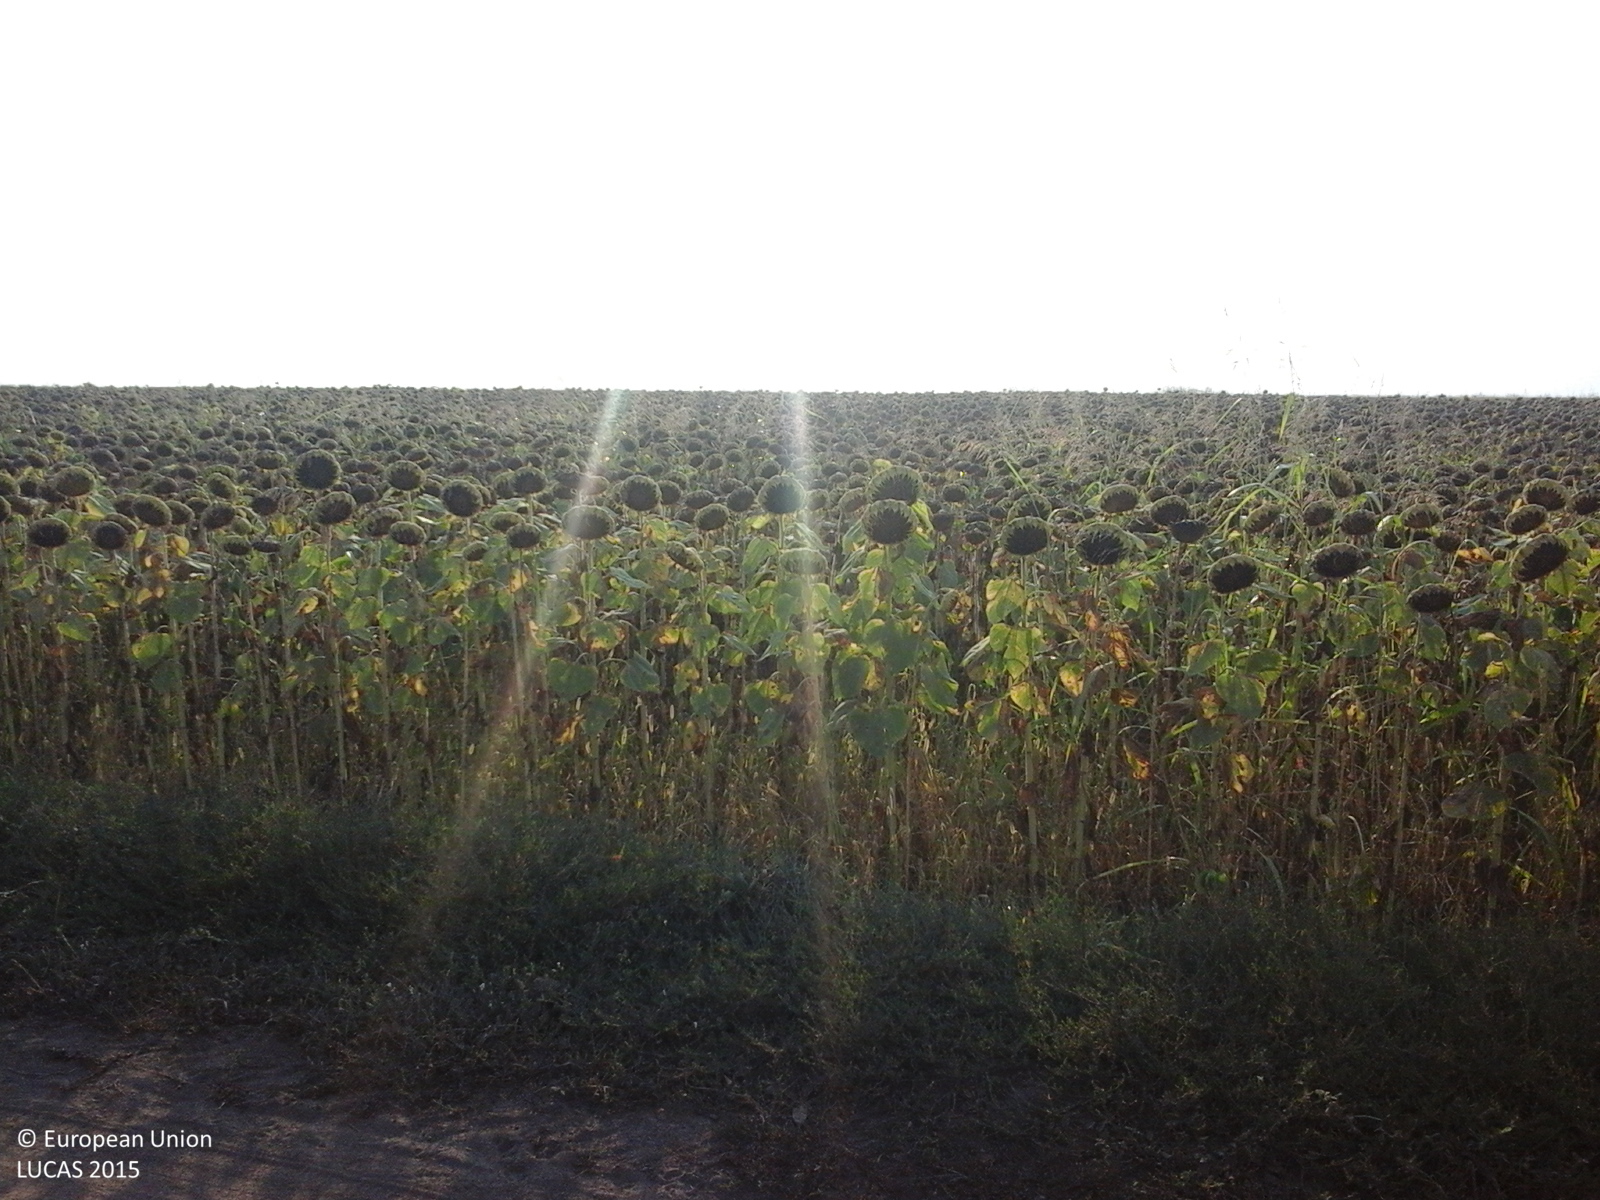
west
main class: Cropland
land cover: Maize
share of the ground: > 75 %
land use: Agriculture (excluding fallow land and kitchen gardens)
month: August
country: RO
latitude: 43.9783
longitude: 23.1962
